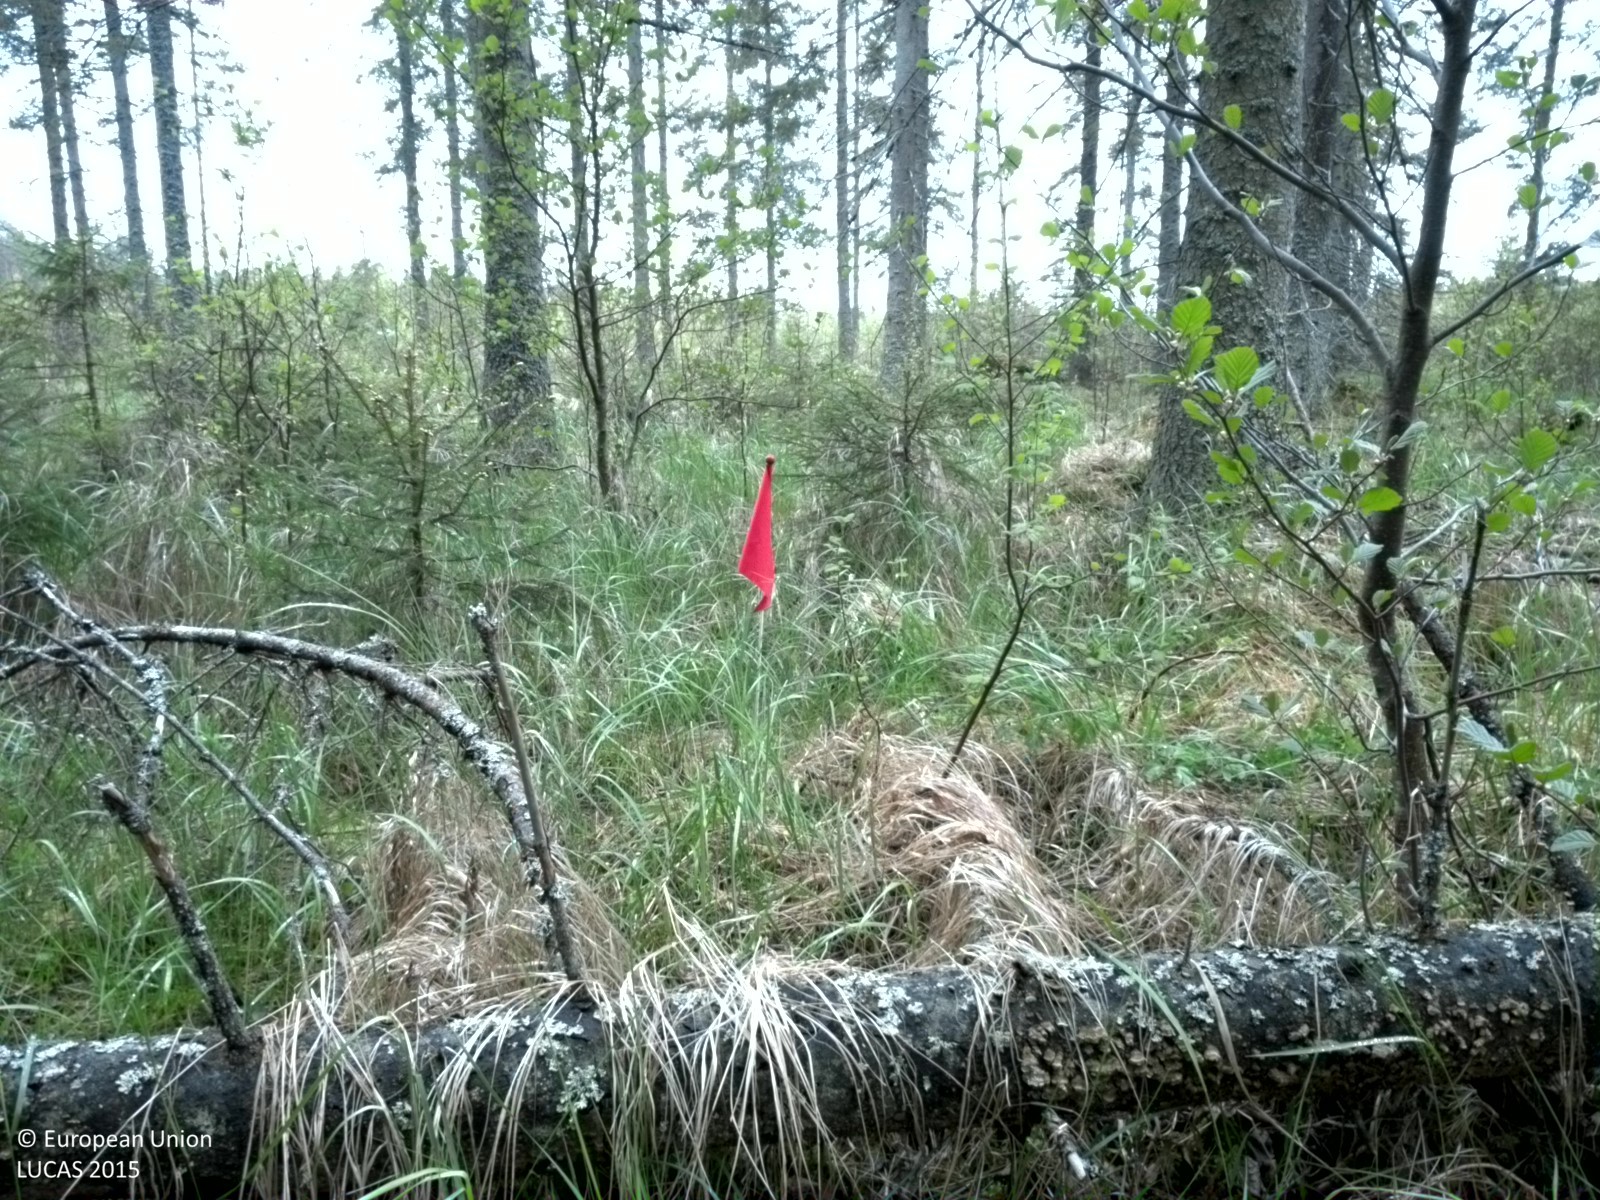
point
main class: Woodland
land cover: Spruce dominated coniferous woodland
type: boreal forest
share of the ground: > 75 %
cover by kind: coniferous forest trees 75 %, herbaceous plants 15 %, broadleaved forest trees 5 %
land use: Forestry
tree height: > 5 m
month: May
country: SE
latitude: 60.2255
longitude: 17.9916
